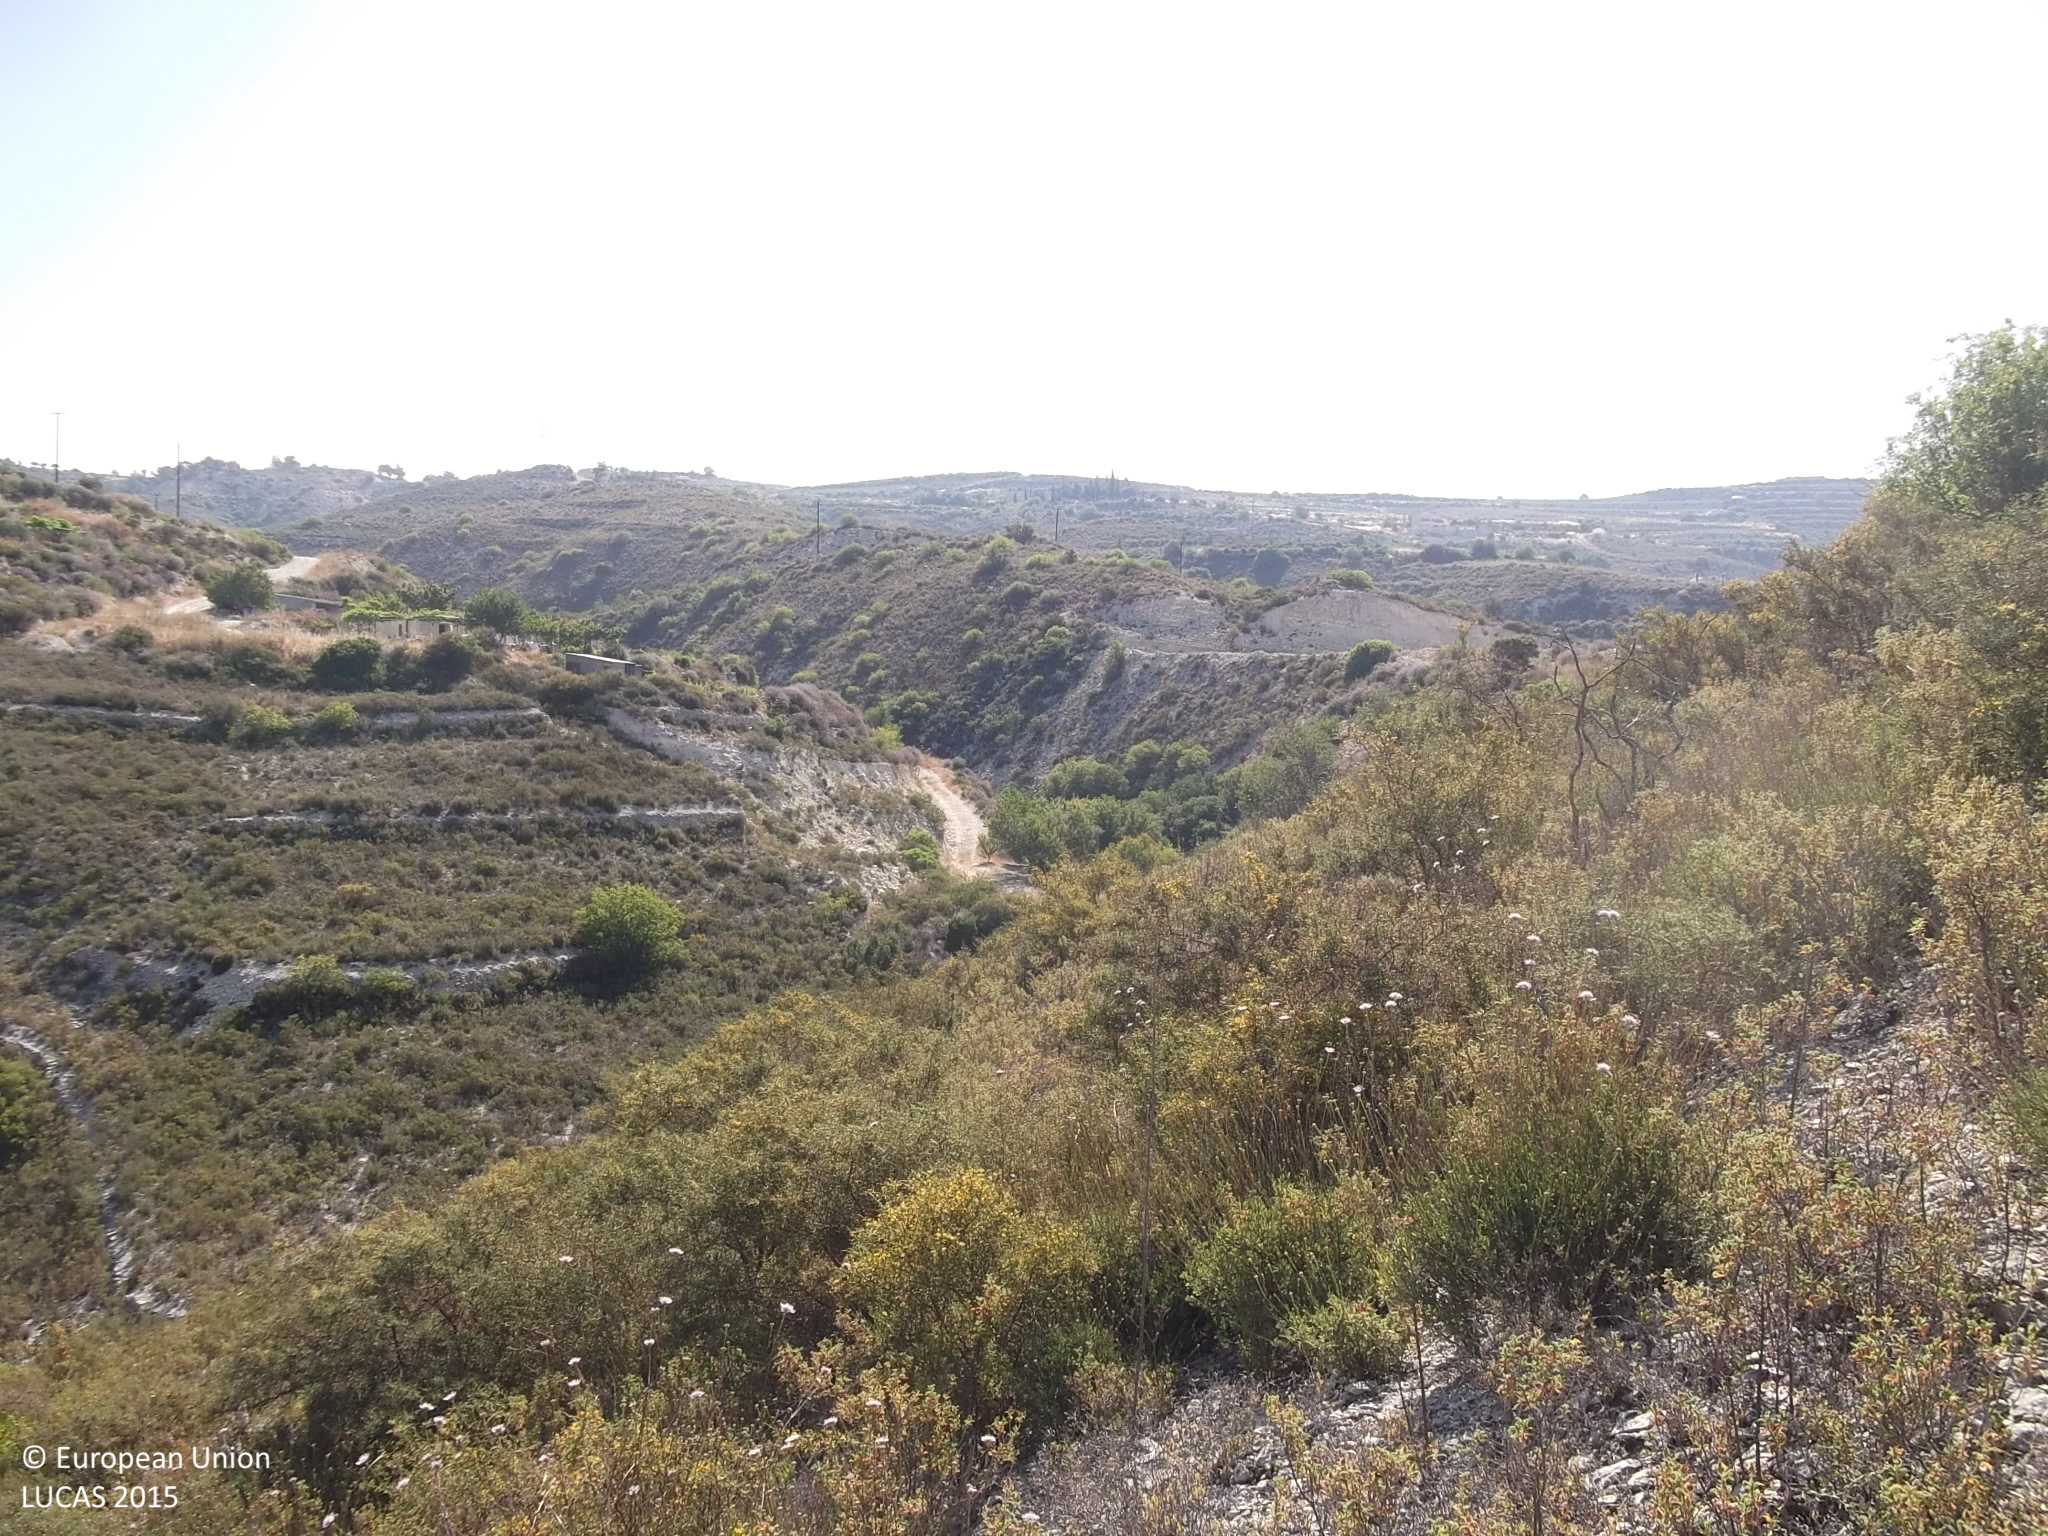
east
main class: Shrubland
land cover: Shrubland without tree cover
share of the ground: 25 - 50 %
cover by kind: shrubs 50 %, unconsolidated bare surface 40 %, consolidated bare surface 10 %
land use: Semi-natural and natural areas not in use
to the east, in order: Shrubland without tree cover; Dry stone walls; Shrubland with sparse tree cover; Rivers and streams; Shrubland with sparse tree cover; Dry stone walls; Shrubland without tree cover; Dry stone walls; Shrubland without tree cover; Dry stone walls; Shrubland with sparse tree cover; Grassland without tree/shrub cover; Tracks; Shrubland without tree cover; Rock outcrops; Shrubland without tree cover
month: June
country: CY
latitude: 34.8331
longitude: 32.9201
